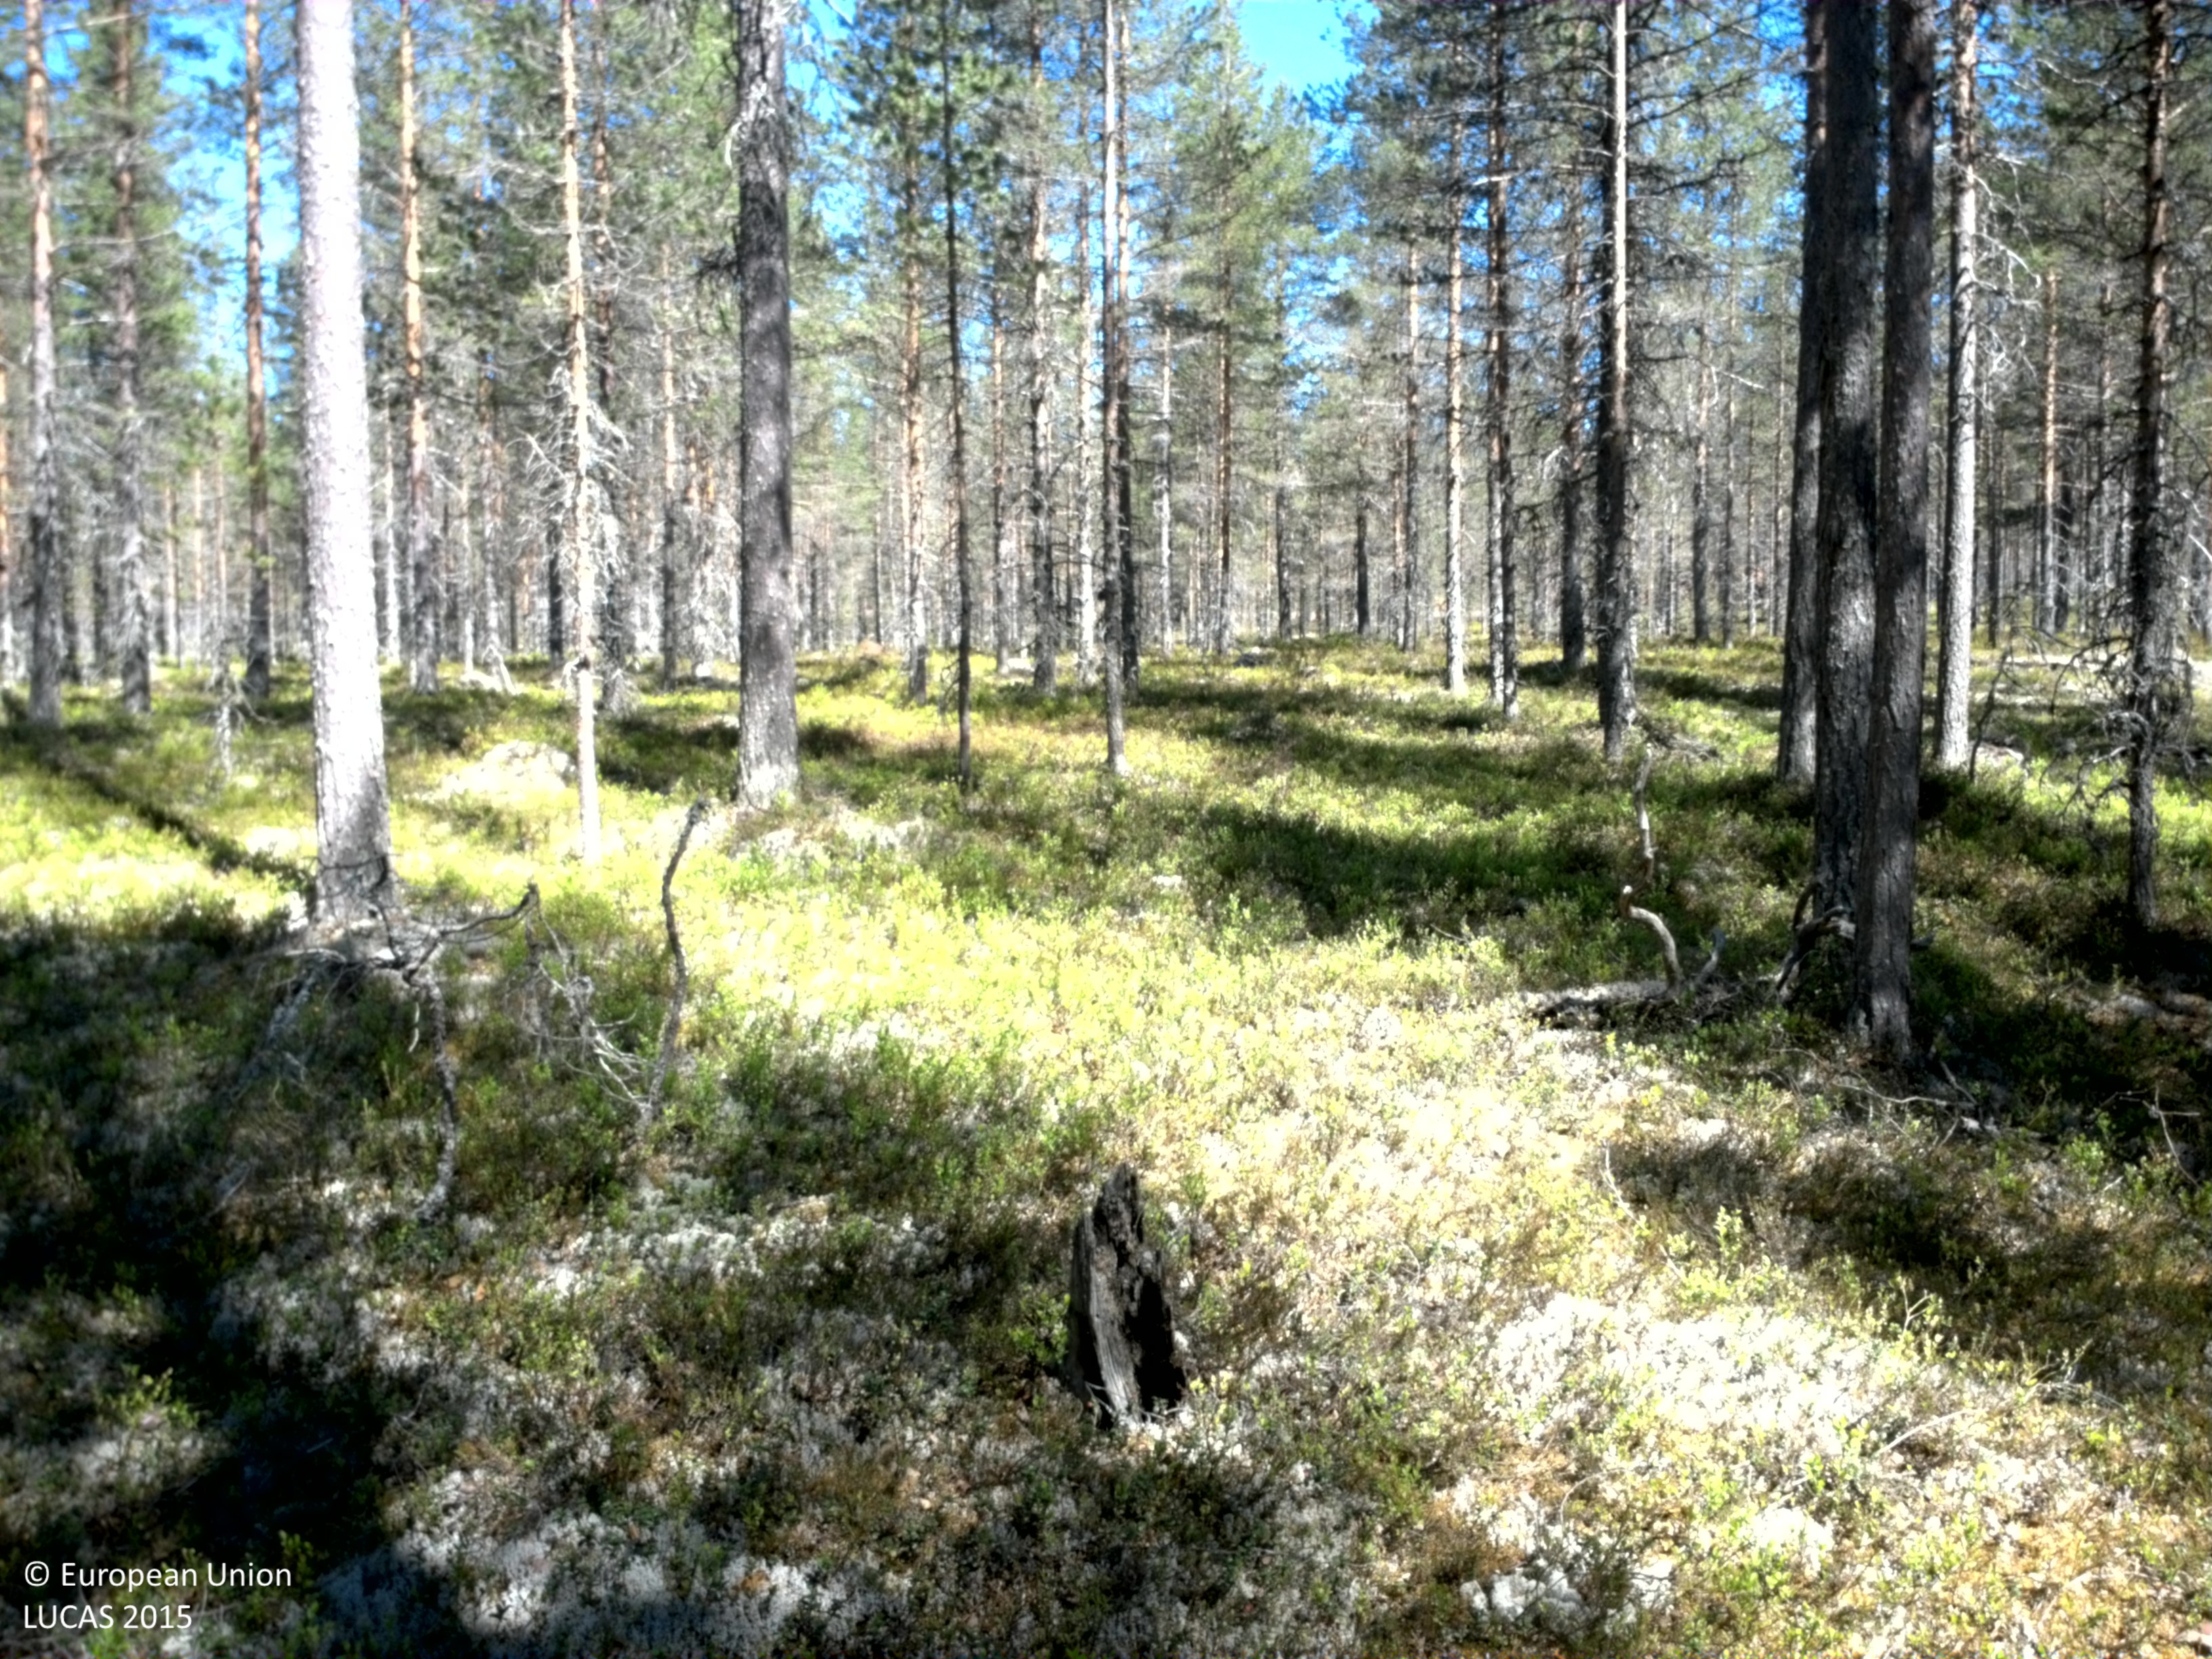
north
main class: Woodland
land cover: Pine dominated coniferous woodland
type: boreal forest
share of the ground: > 75 %
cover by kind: coniferous forest trees 75 %, herbaceous plants 15 %, lichens and mosses 10 %
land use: Forestry
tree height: > 5 m
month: June
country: SE
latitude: 61.3957
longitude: 13.6384
